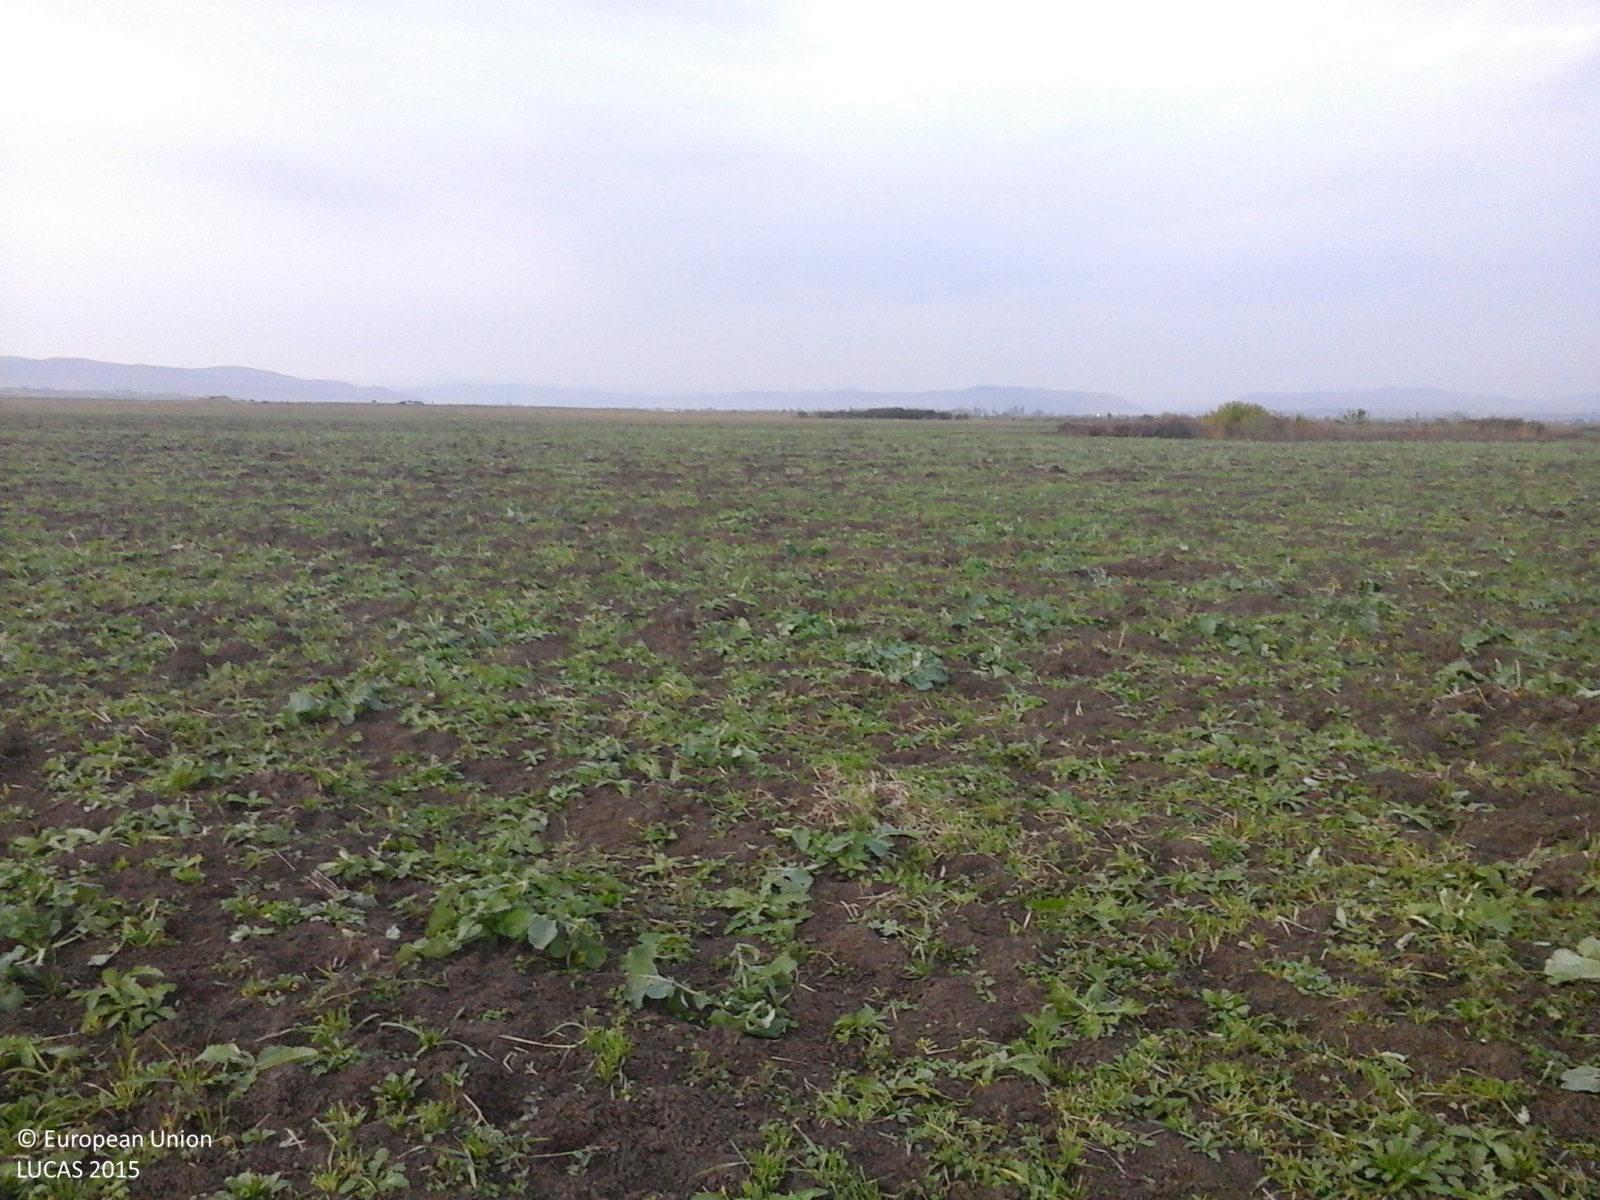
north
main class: Cropland
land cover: Rape and turnip rape
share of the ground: 50 - 75 %
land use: Agriculture (excluding fallow land and kitchen gardens)
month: October
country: RO
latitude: 45.1682
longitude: 26.7322
